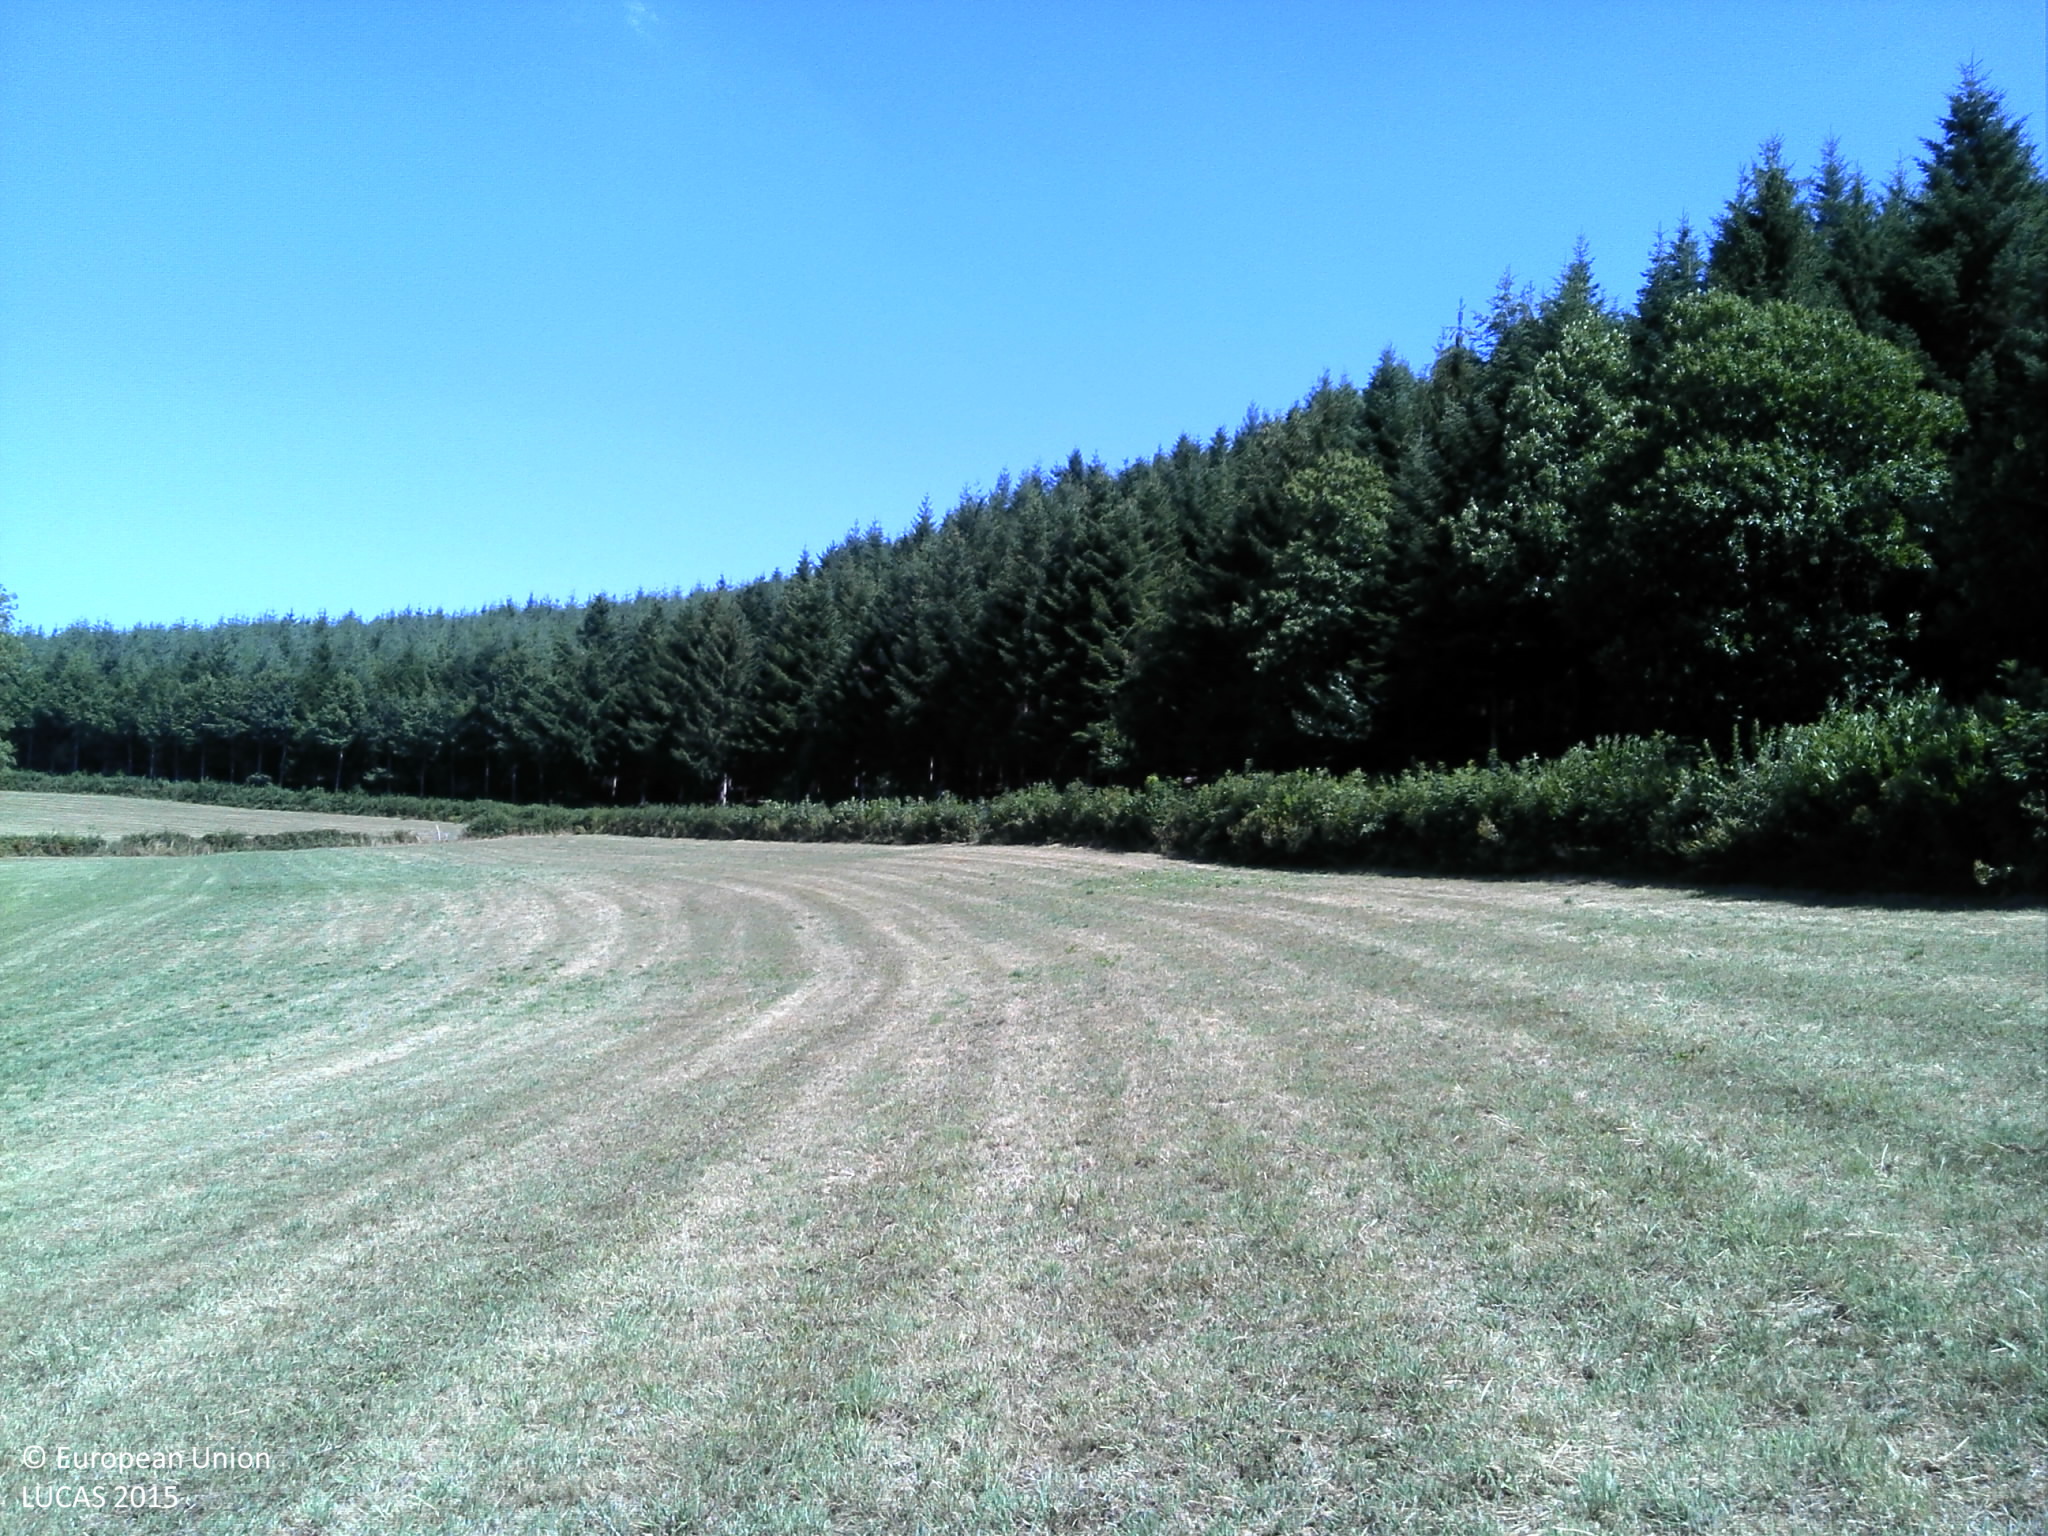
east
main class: Grassland
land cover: Grassland without tree/shrub cover
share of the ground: > 75 %
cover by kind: herbaceous plants 100 %
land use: Agriculture (excluding fallow land and kitchen gardens)
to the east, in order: Grassland without tree/shrub cover; Abandoned hedges; Fences; Grass margins; Paved roads, cycling and walking lanes; Grass margins; Ditches and canals; Spruce dominated coniferous woodland
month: August
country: FR
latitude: 46.2054
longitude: 4.4159
